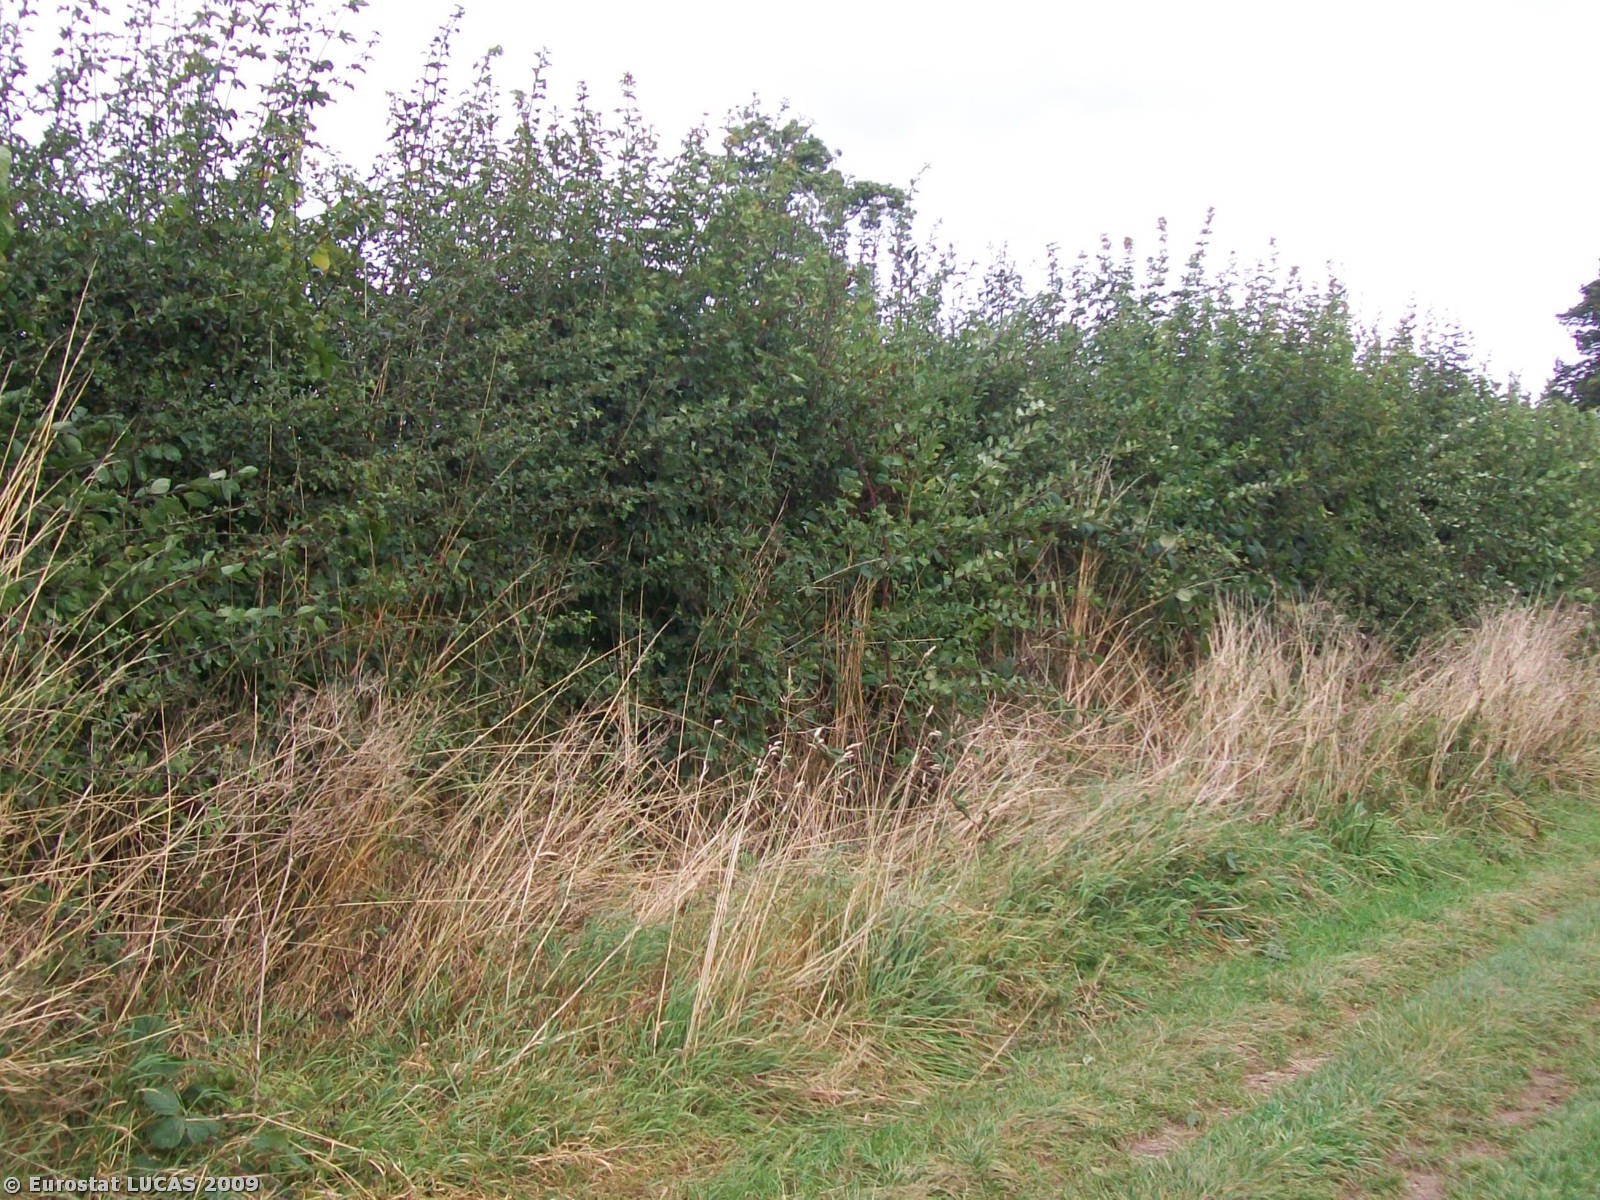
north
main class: Cropland
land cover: Common wheat
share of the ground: < 10 %
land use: Agriculture (excluding fallow land and kitchen gardens)
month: September
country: GB
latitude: 52.5832
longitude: -2.5380
